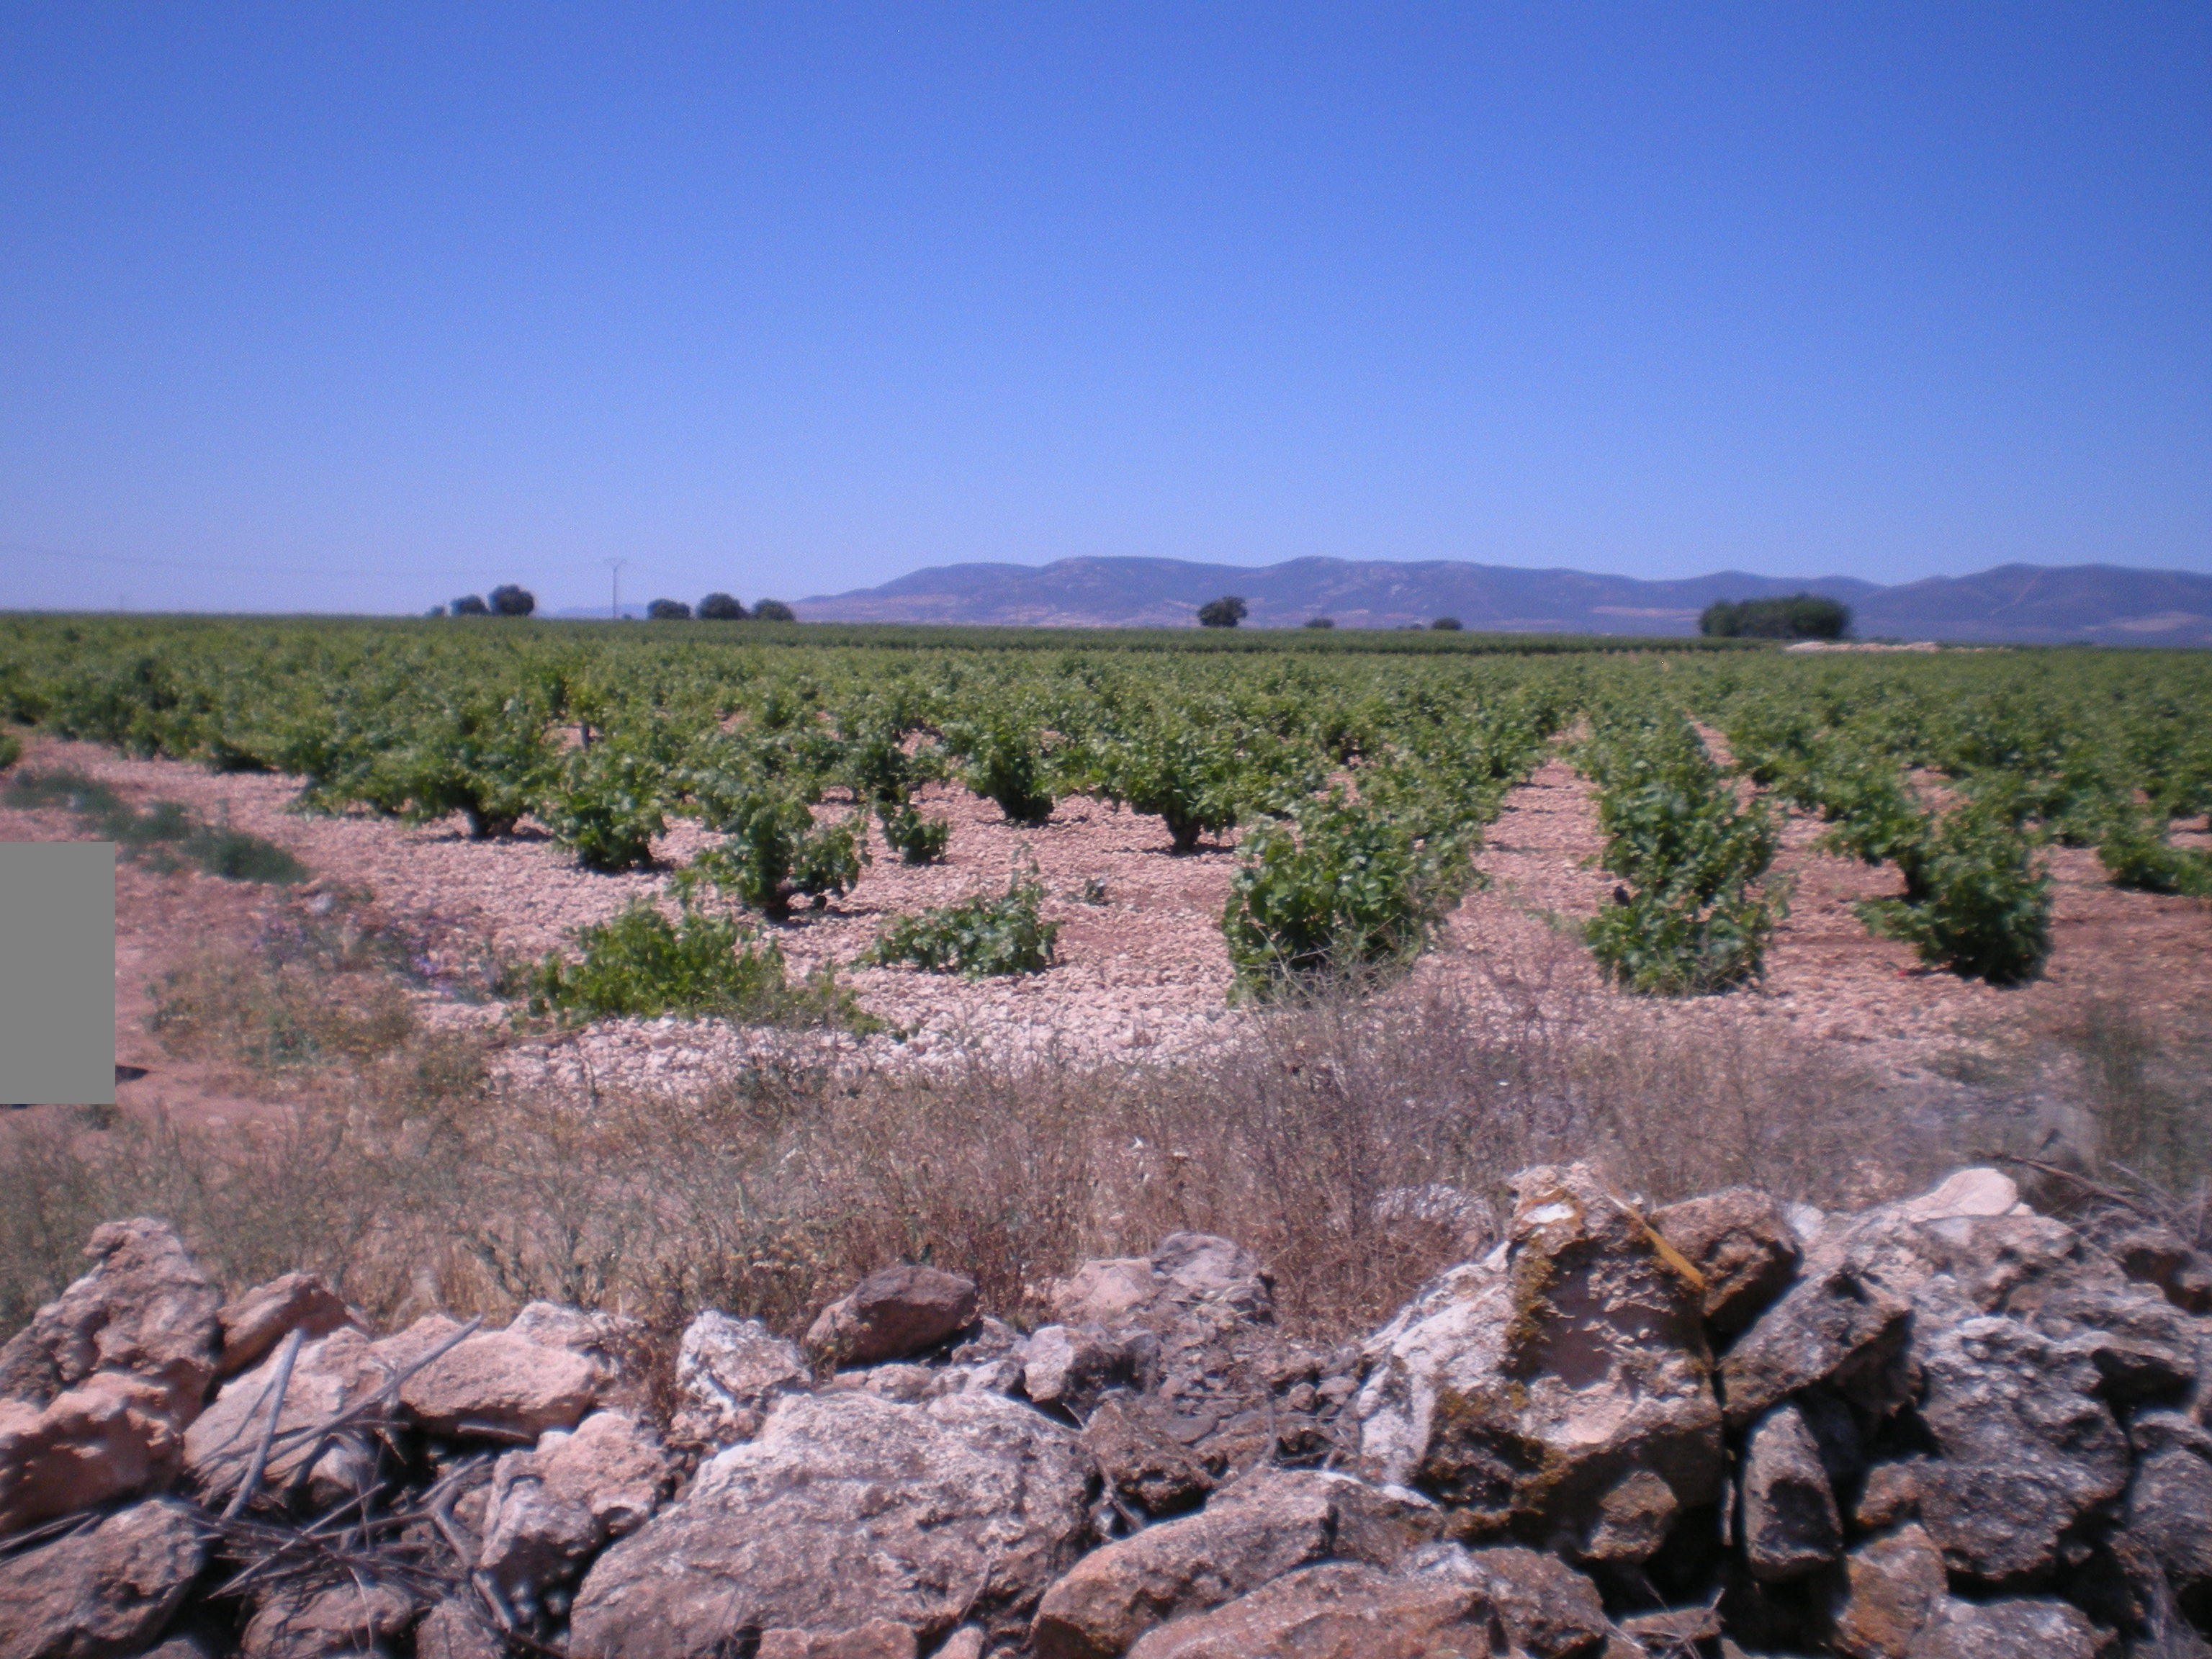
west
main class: Cropland
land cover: Barley
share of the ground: > 75 %
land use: Agriculture (excluding fallow land and kitchen gardens)
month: May
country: ES
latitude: 39.2065
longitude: -3.4630
